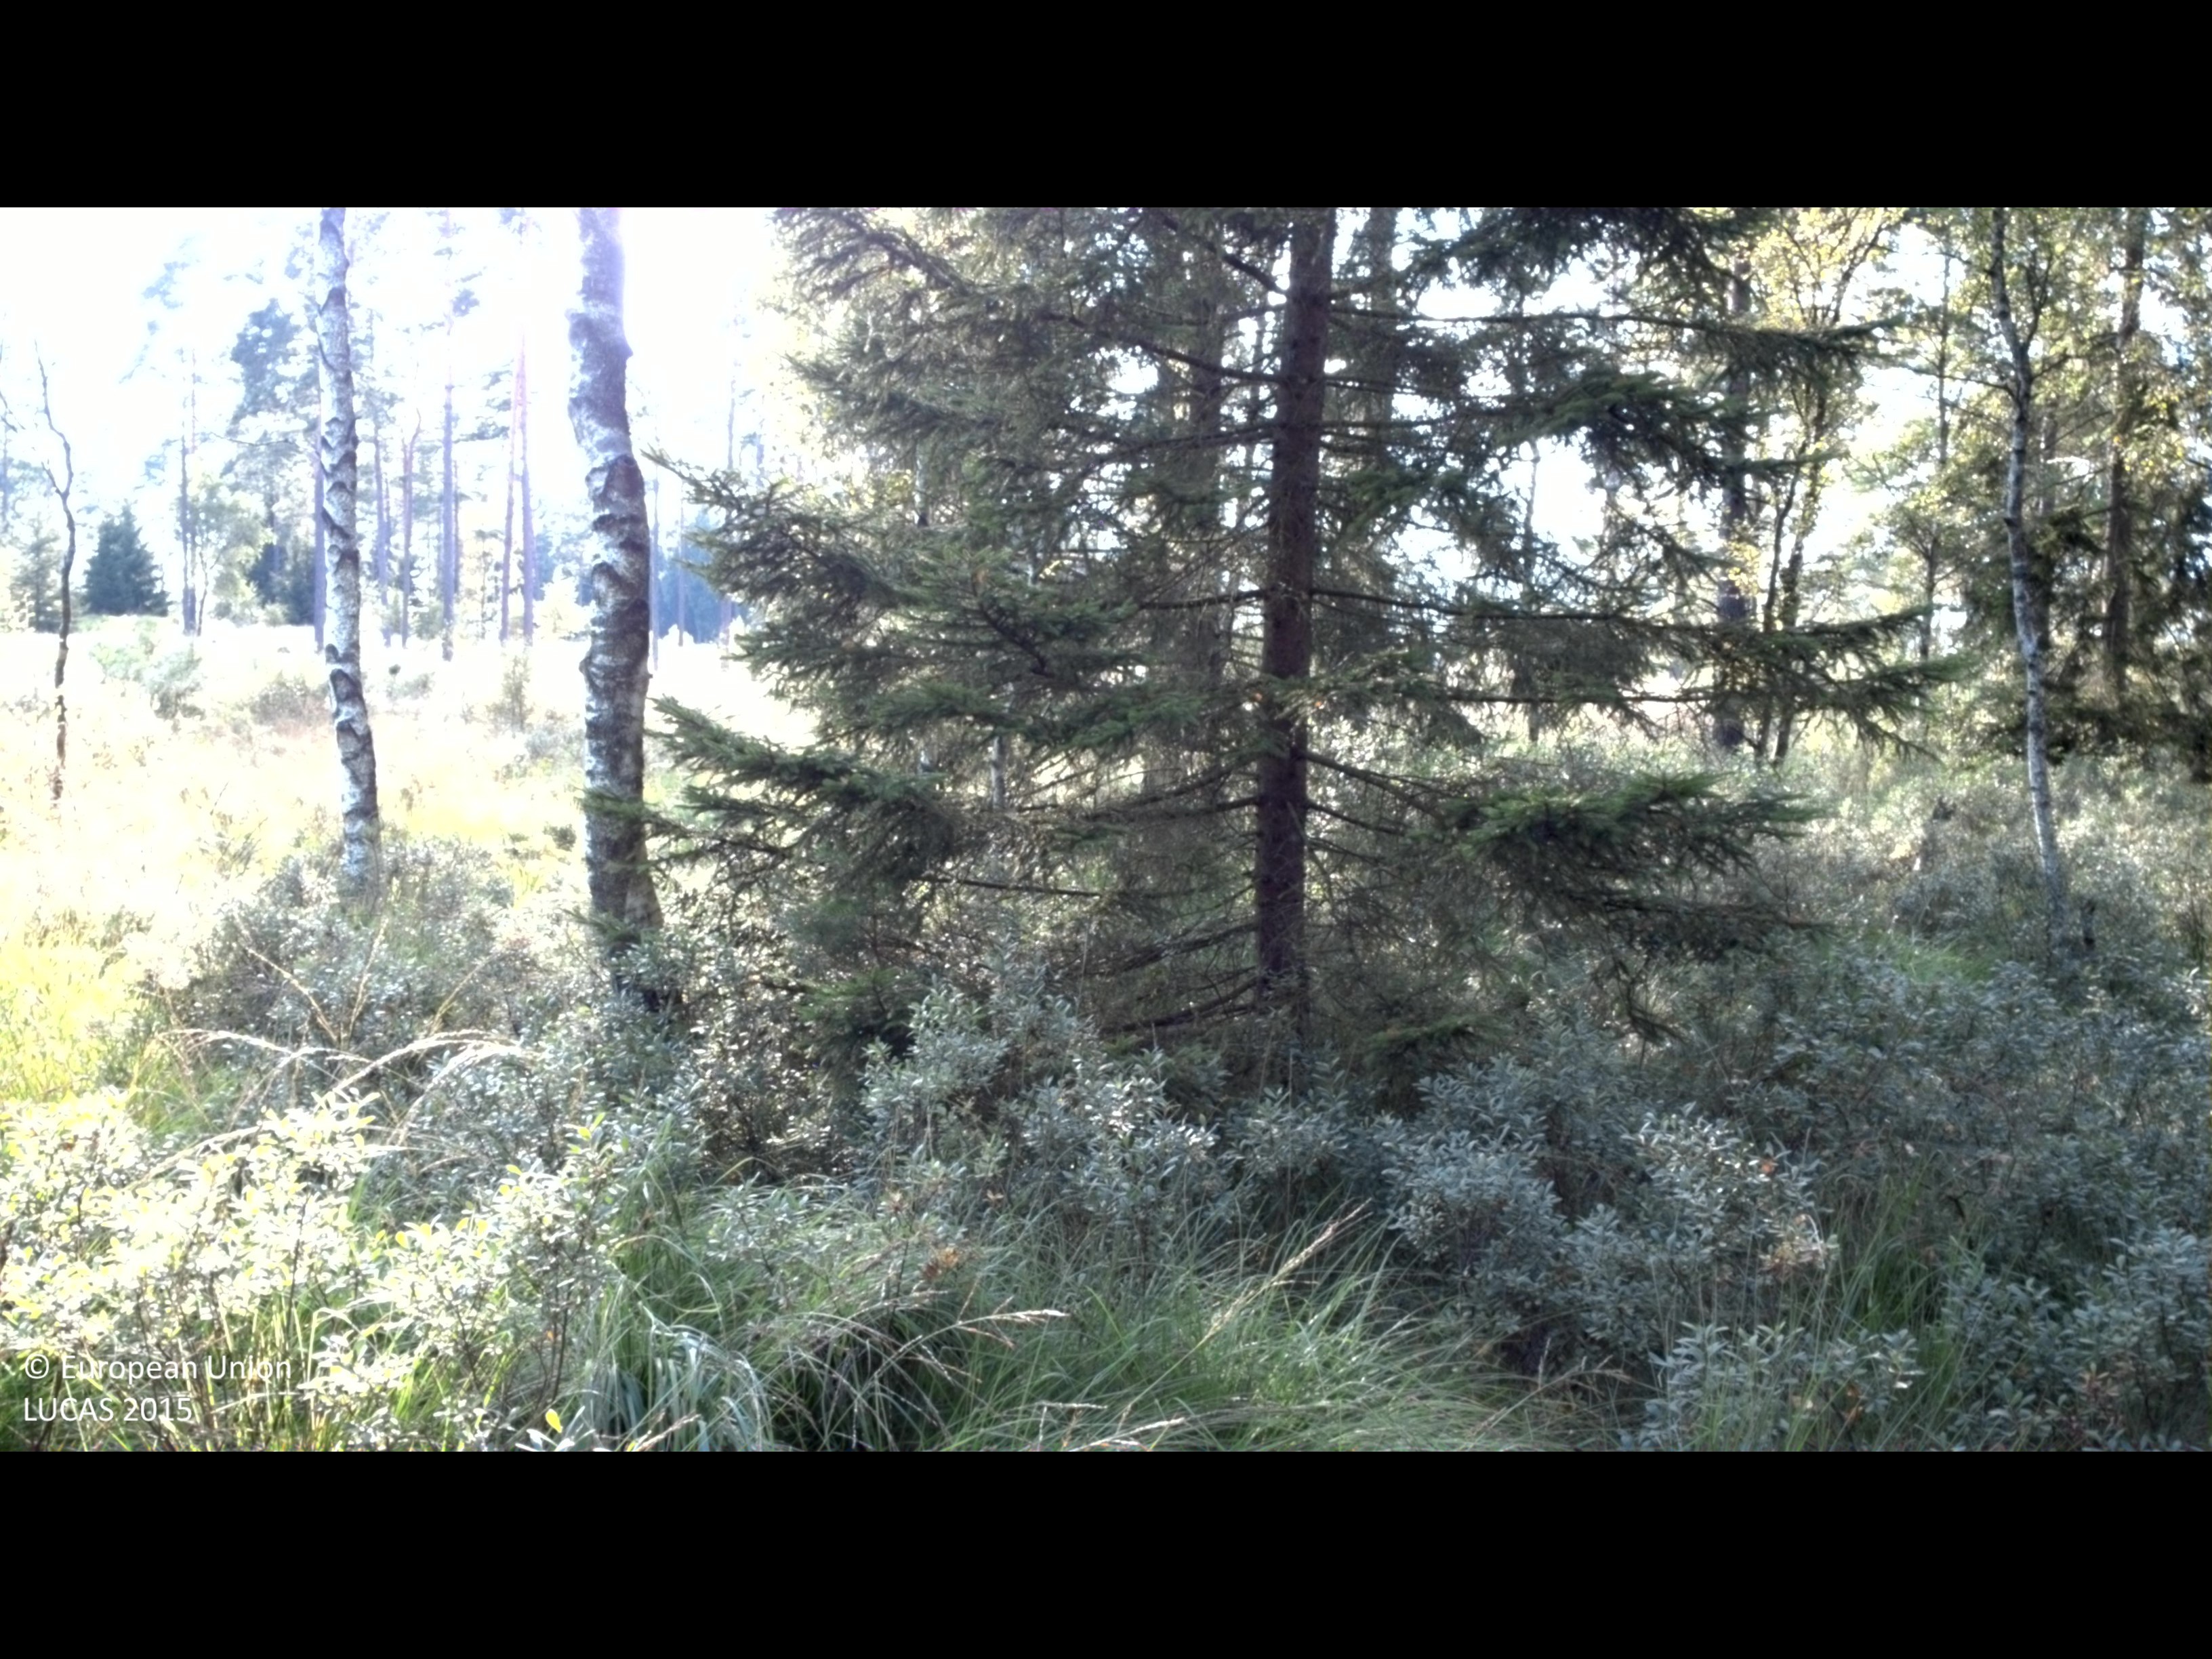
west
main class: Woodland
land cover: Pine dominated mixed woodland
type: boreal forest
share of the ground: 50 - 75 %
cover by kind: broadleaved forest trees 40 %, shrubs 25 %, herbaceous plants 20 %, coniferous forest trees 15 %
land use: Semi-natural and natural areas not in use
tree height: > 5 m
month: August
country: SE
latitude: 56.7233
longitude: 13.2160
